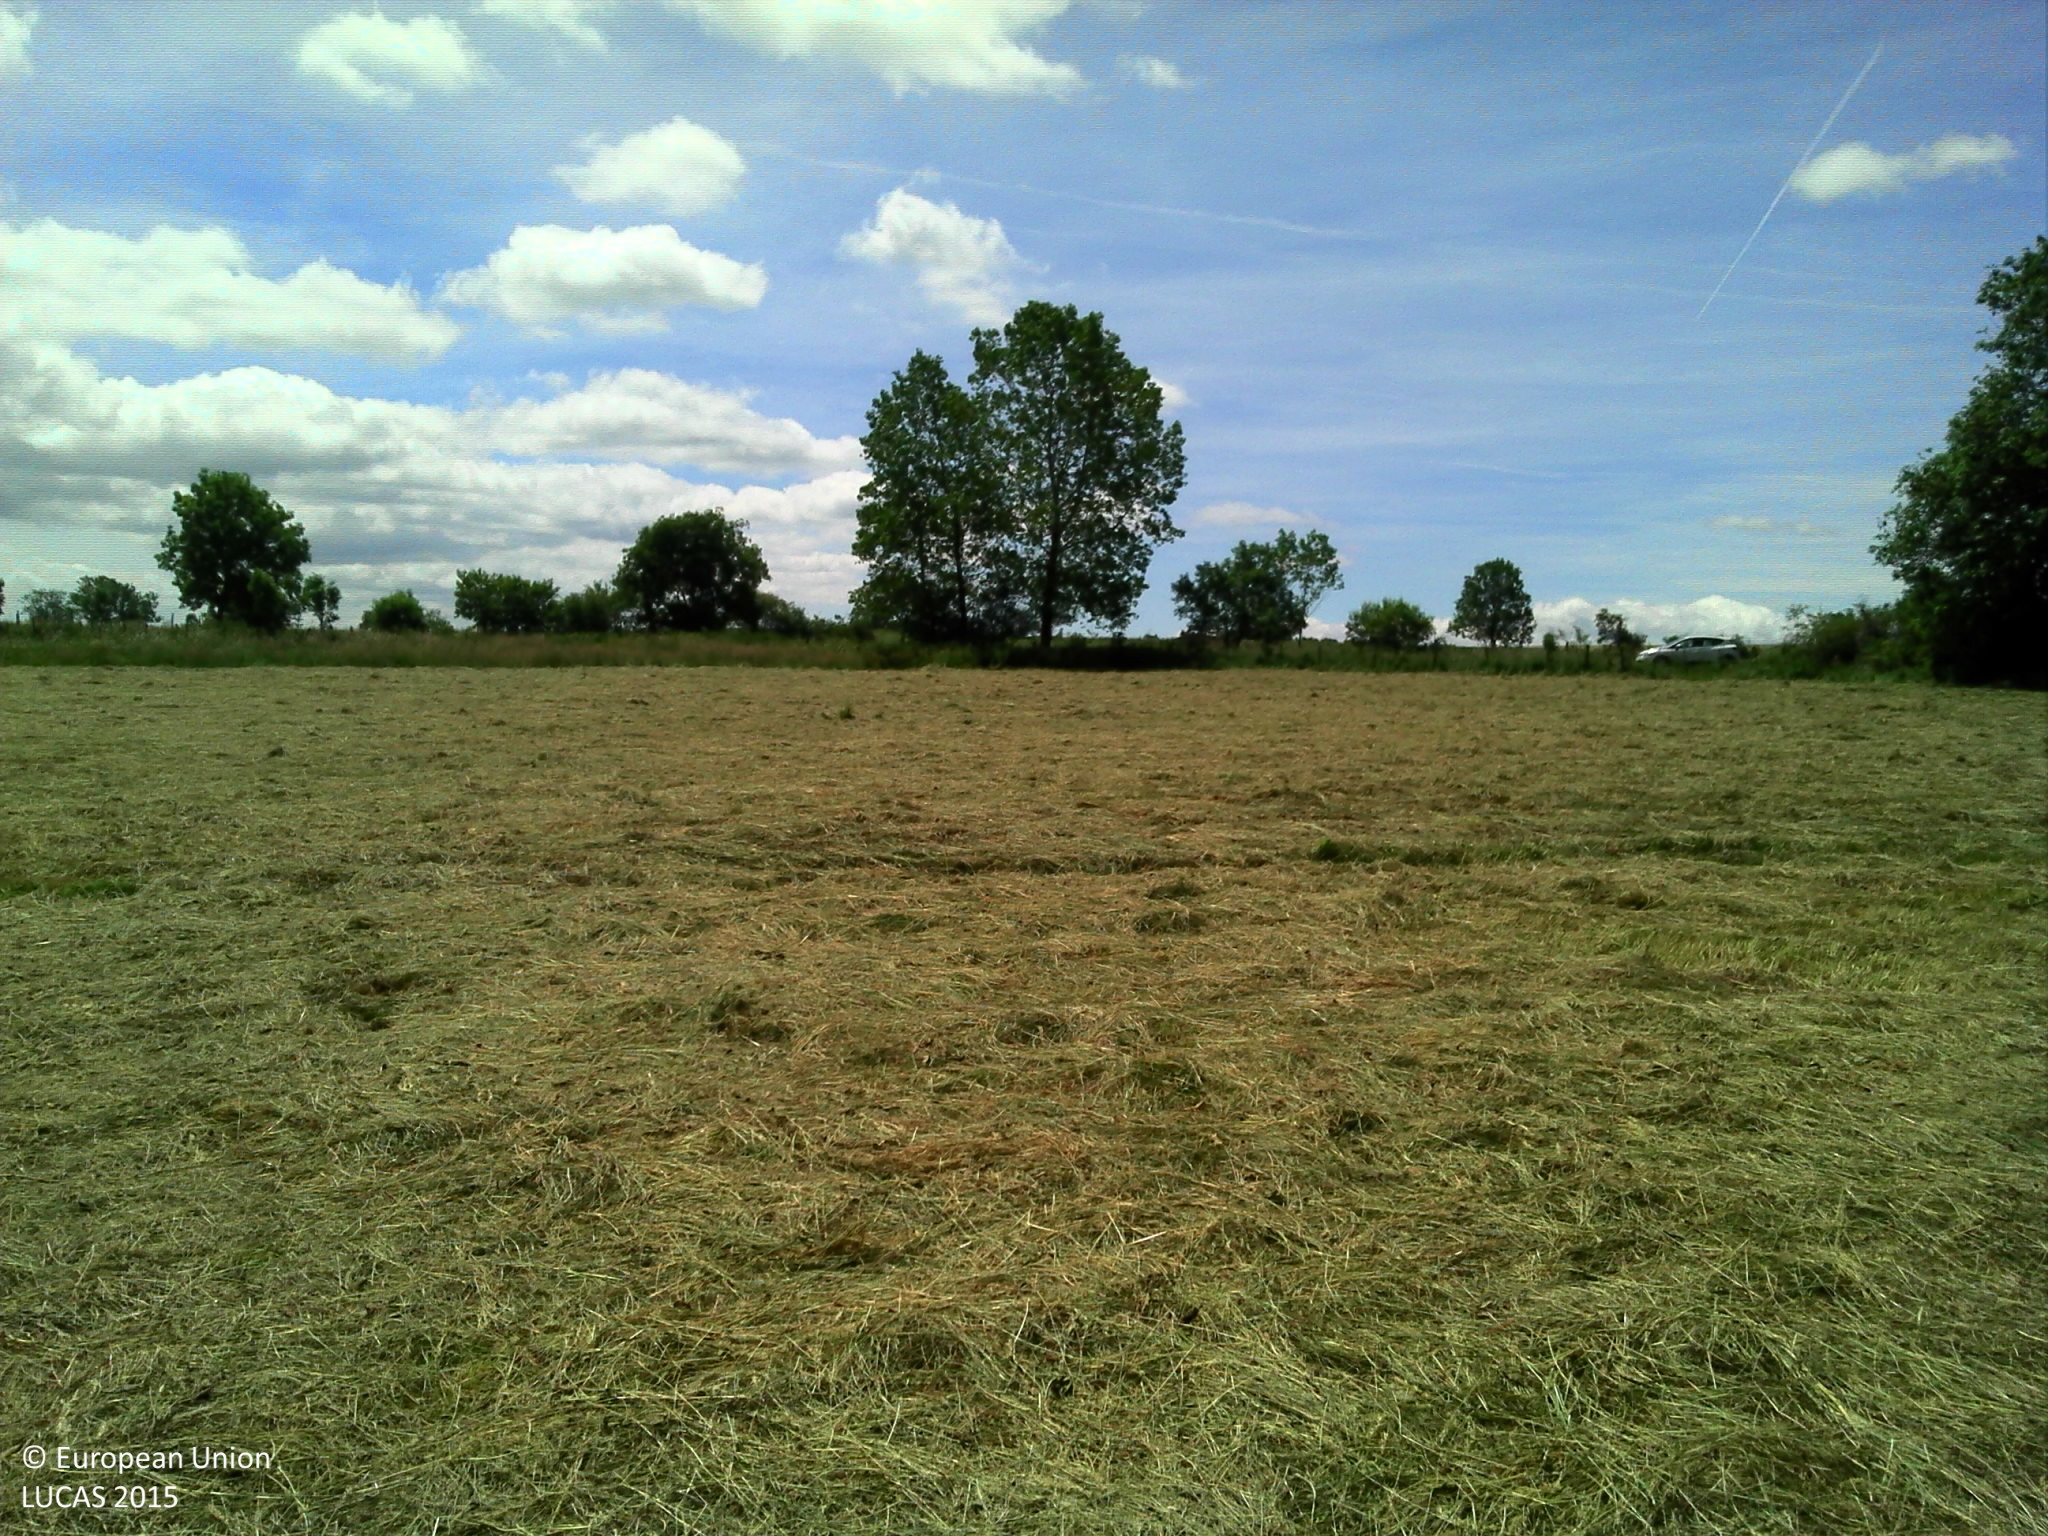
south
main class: Grassland
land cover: Grassland without tree/shrub cover
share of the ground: > 75 %
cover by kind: herbaceous plants 100 %
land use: Agriculture (excluding fallow land and kitchen gardens)
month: June
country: FR
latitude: 45.0143
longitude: 2.9341
